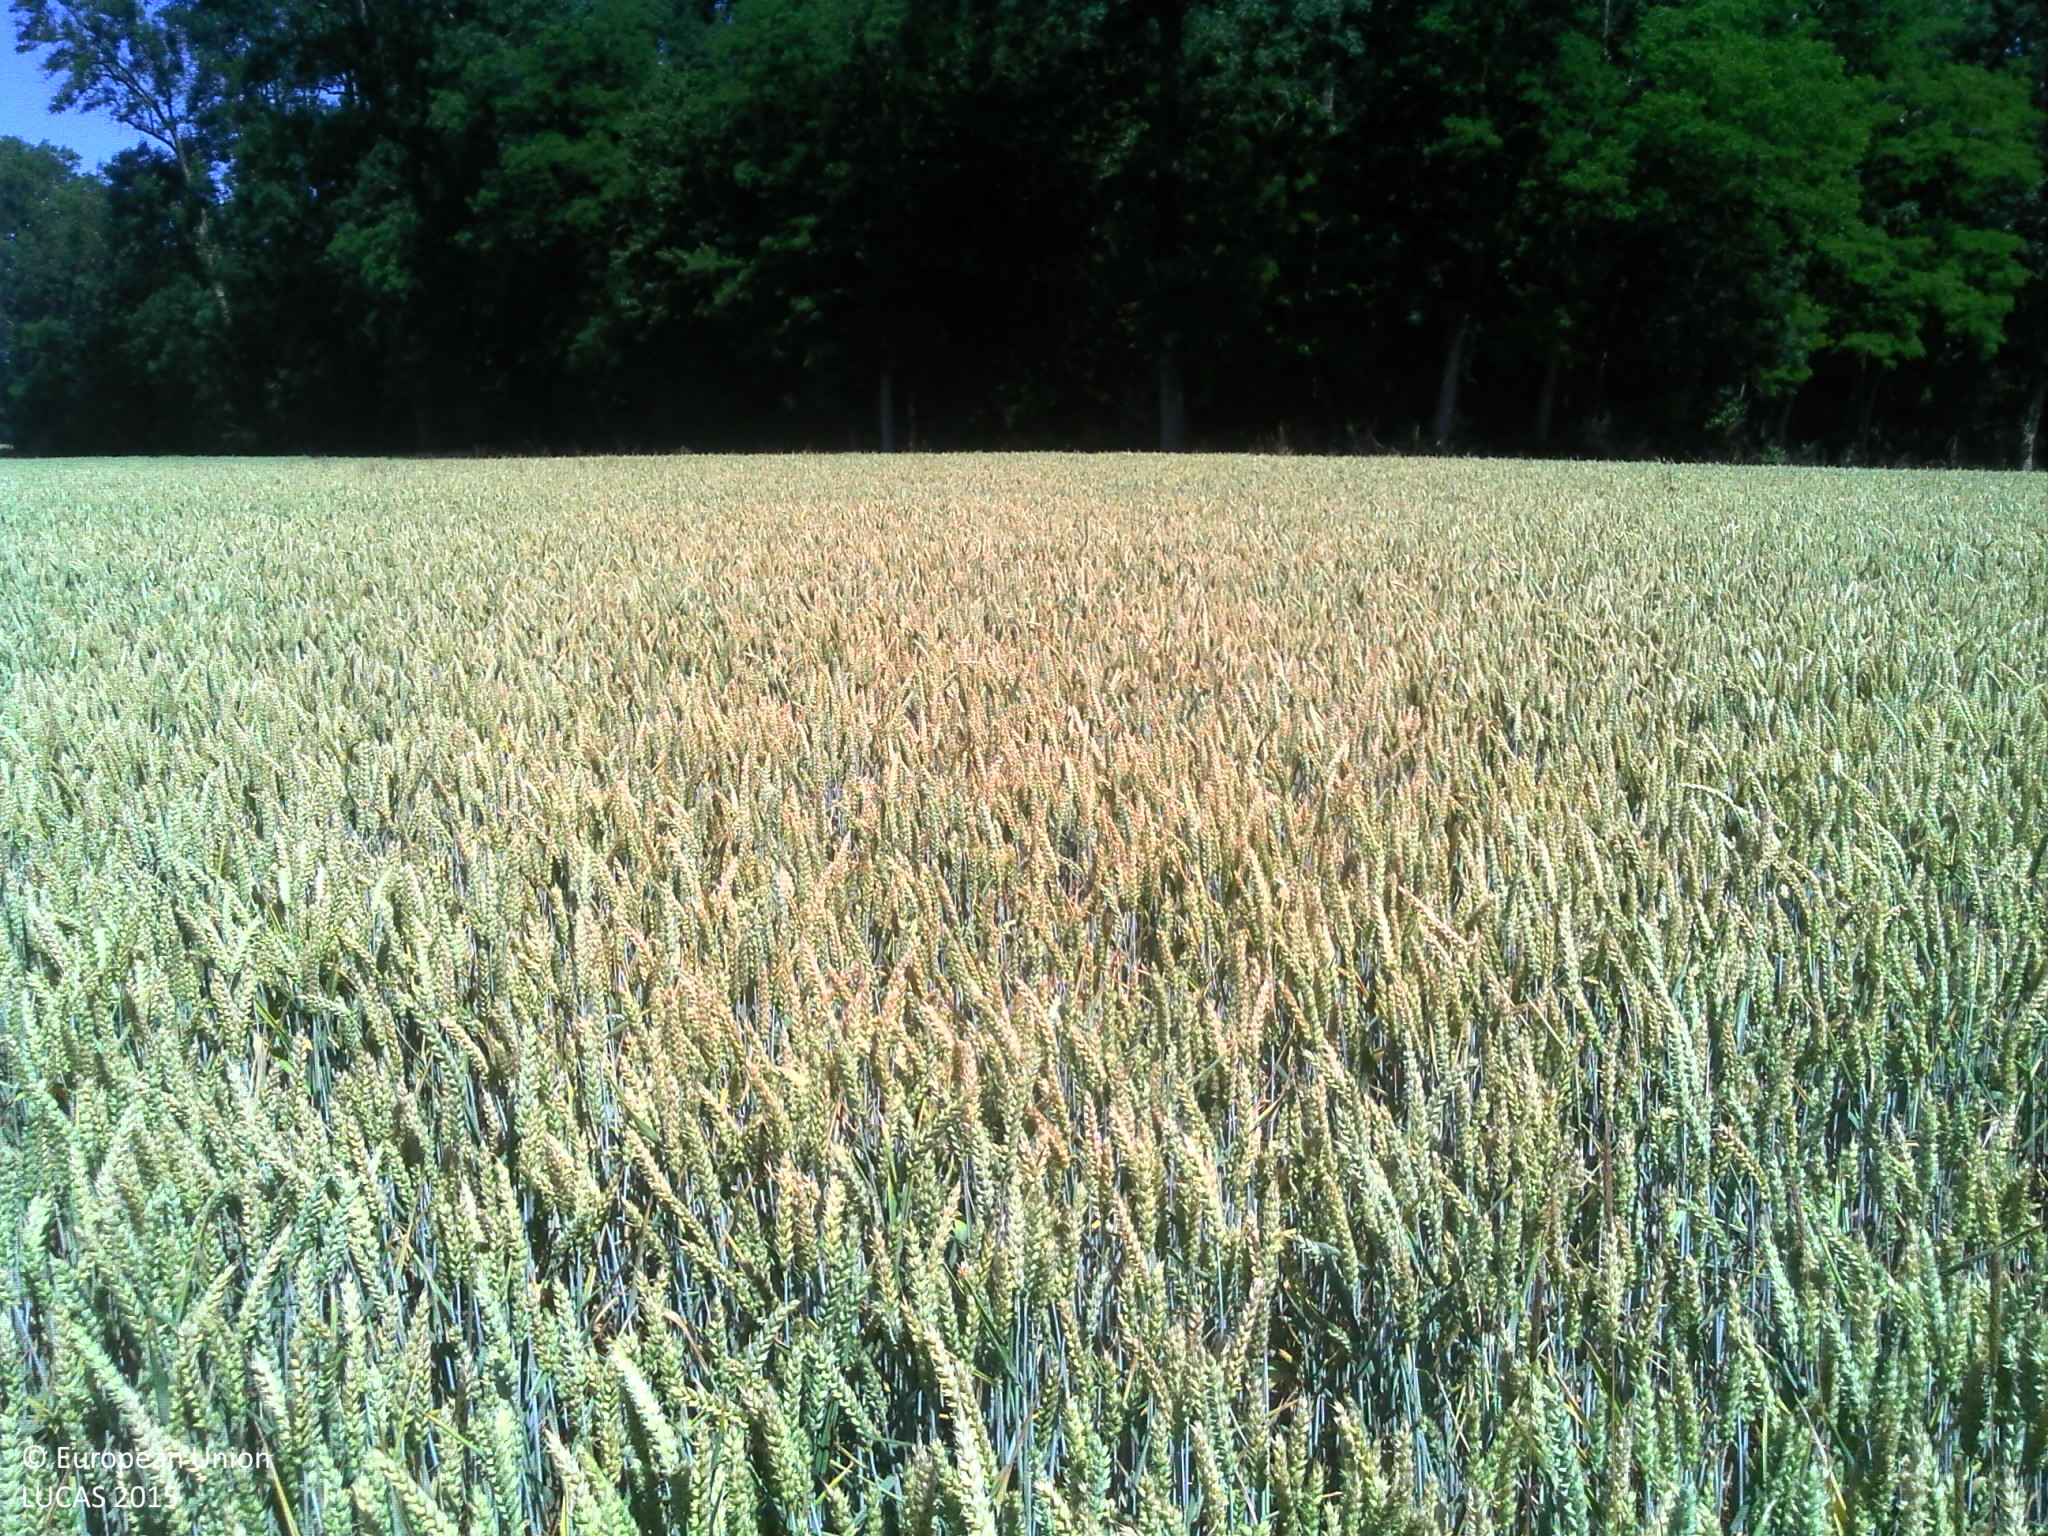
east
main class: Cropland
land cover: Common wheat
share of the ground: > 75 %
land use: Agriculture (excluding fallow land and kitchen gardens)
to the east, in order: Common wheat; Electric lines; Common wheat; Broadleaved woodland; Grassland without tree/shrub cover; Rape and turnip rape; Grassland without tree/shrub cover; Shruby margins
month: June
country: FR
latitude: 48.9641
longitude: 3.3956
